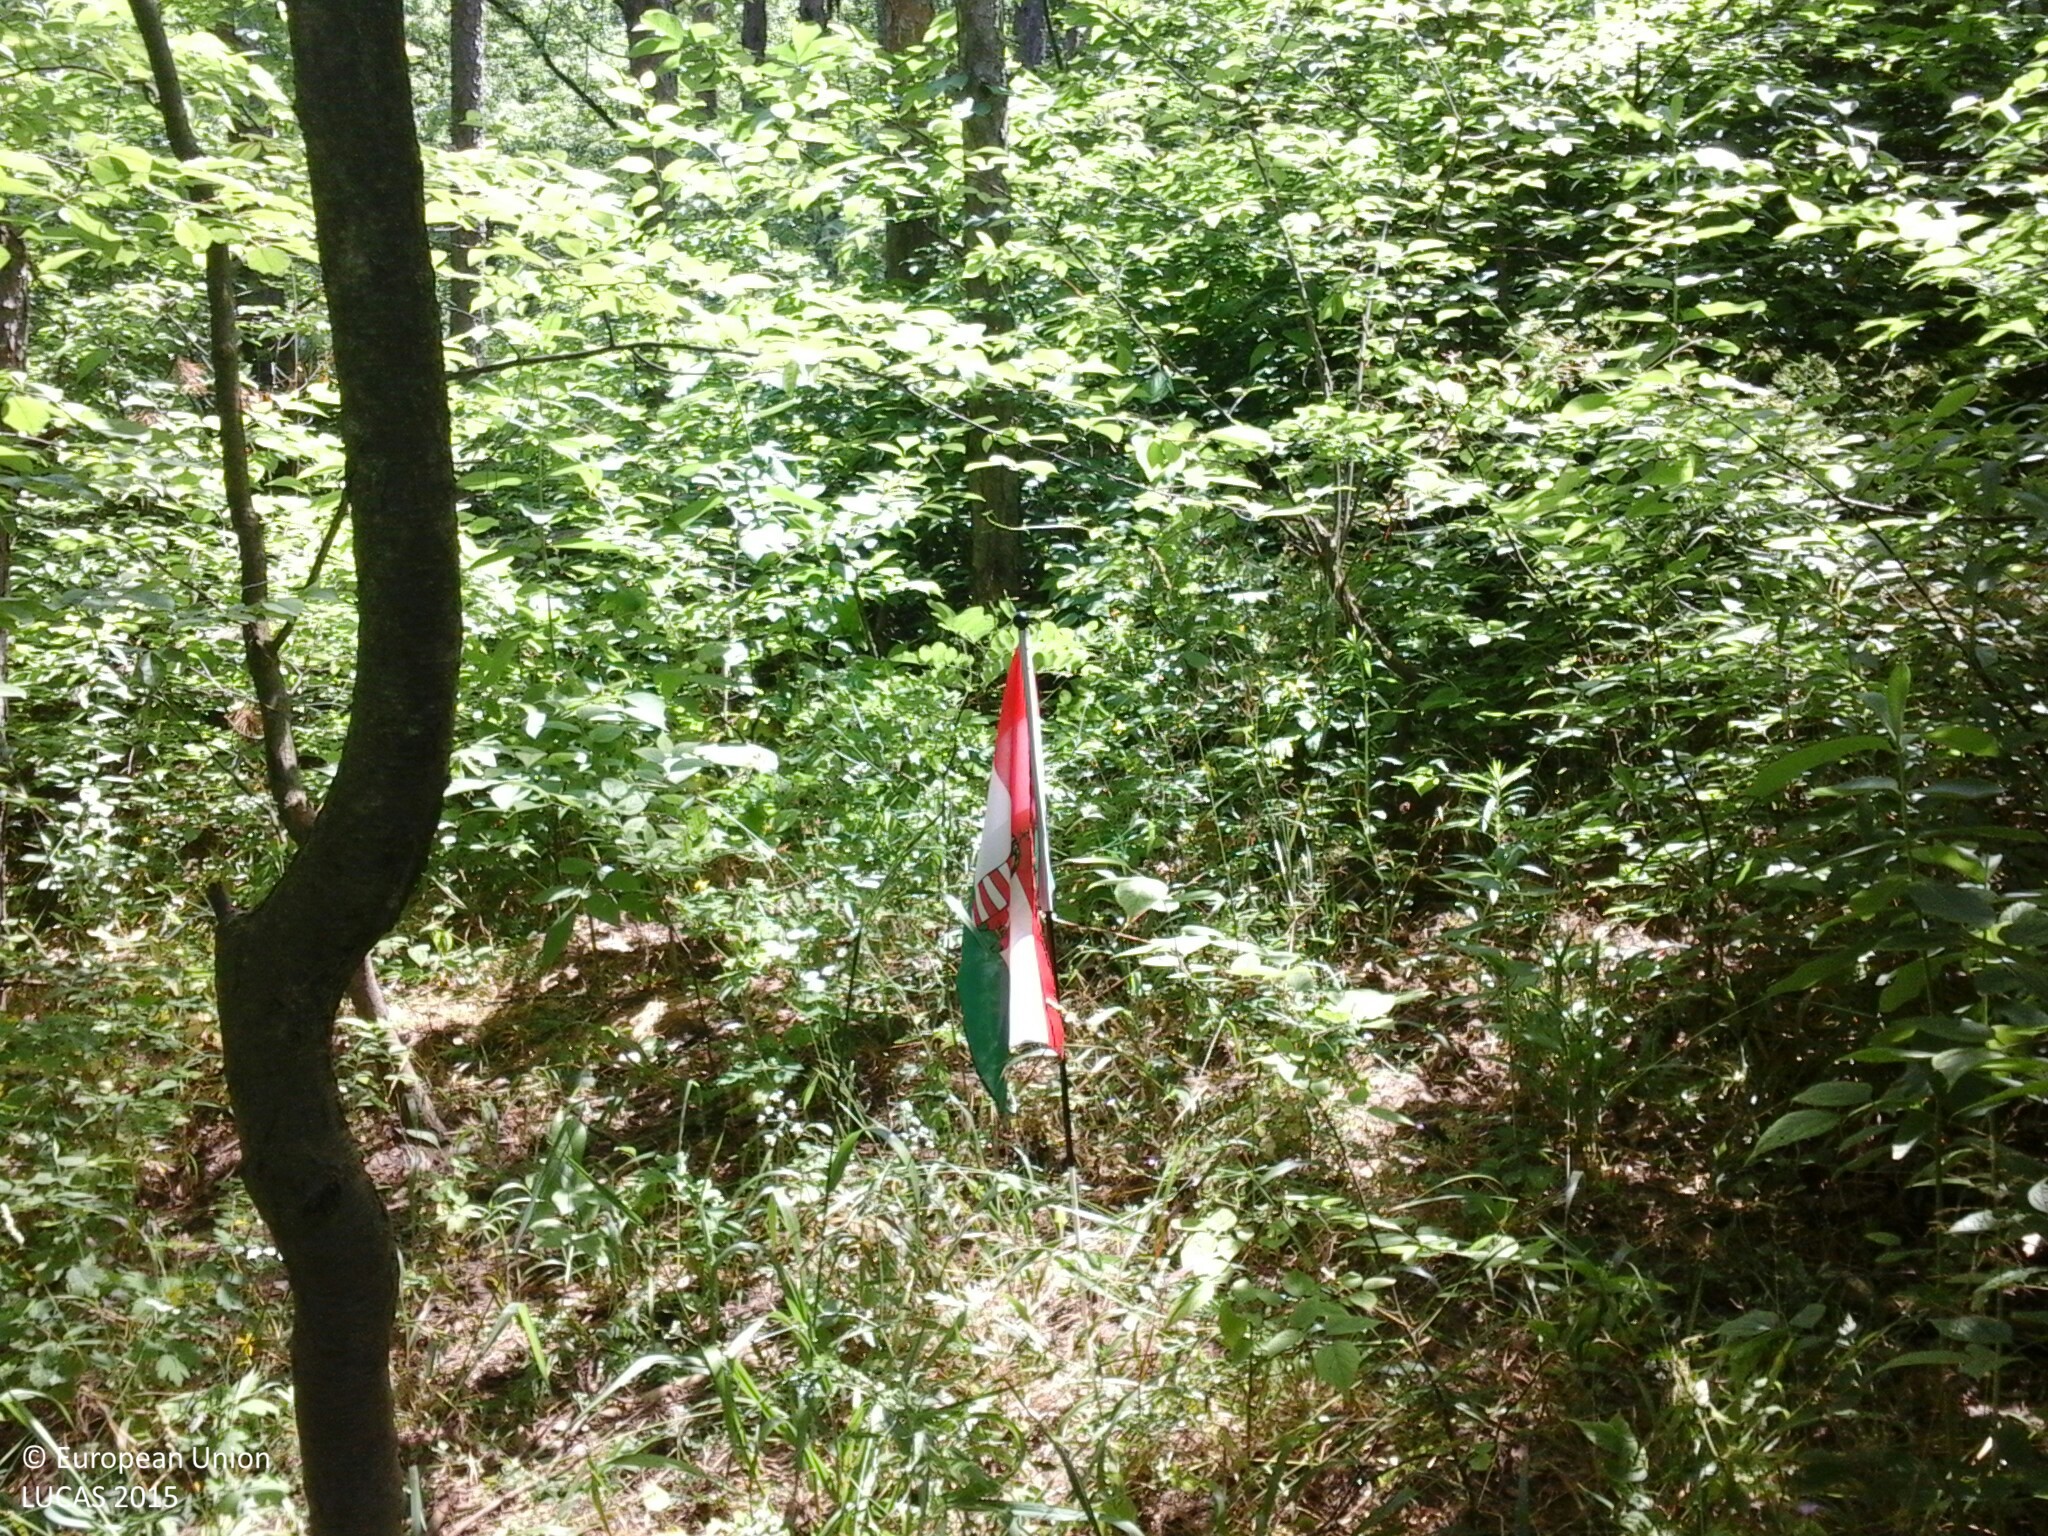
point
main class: Woodland
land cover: Pine dominated coniferous woodland
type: hemiboreal forest and nemoral coniferous forest and mixed broadleaved-coniferous forest
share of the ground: > 75 %
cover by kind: coniferous forest trees 95 %, broadleaved forest trees 5 %
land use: Forestry
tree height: > 5 m
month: June
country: HU
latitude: 47.6372
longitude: 19.4314
